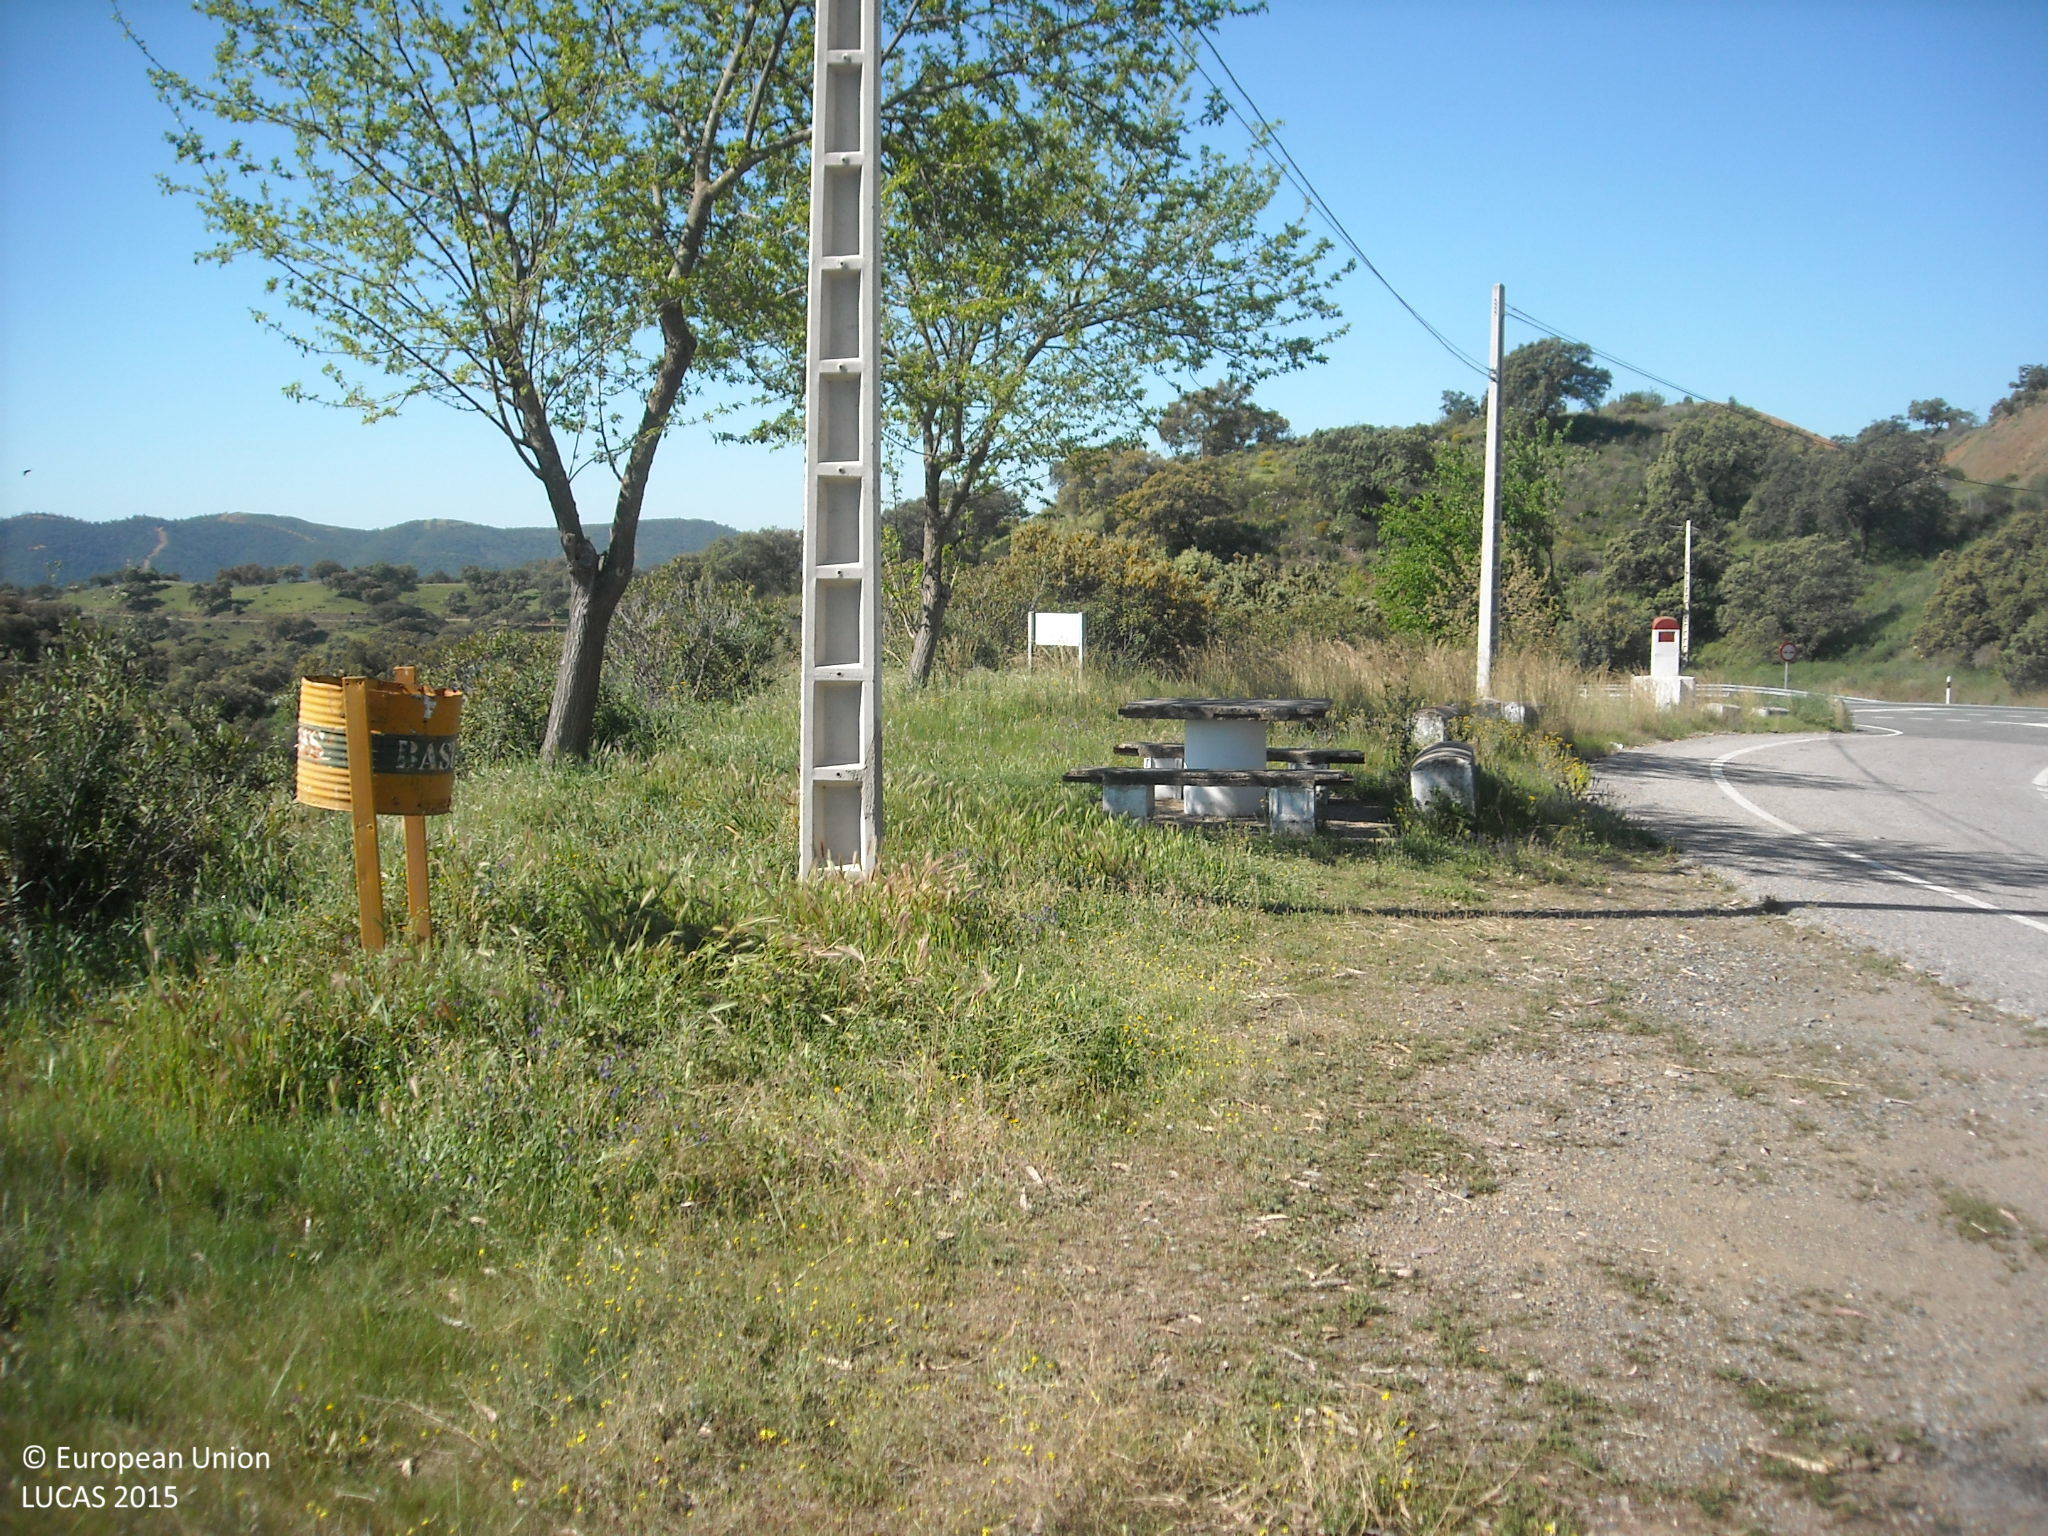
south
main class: Woodland
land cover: Broadleaved woodland
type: broadleaved evergreen forest
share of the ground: 25 - 50 %
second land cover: Grassland without tree/shrub cover
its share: > 75 %
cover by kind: herbaceous plants 60 %, broadleaved forest trees 40 %
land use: Forestry
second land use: Agriculture (excluding fallow land and kitchen gardens)
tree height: > 5 m
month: April
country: ES
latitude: 37.6997
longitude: -6.1720
